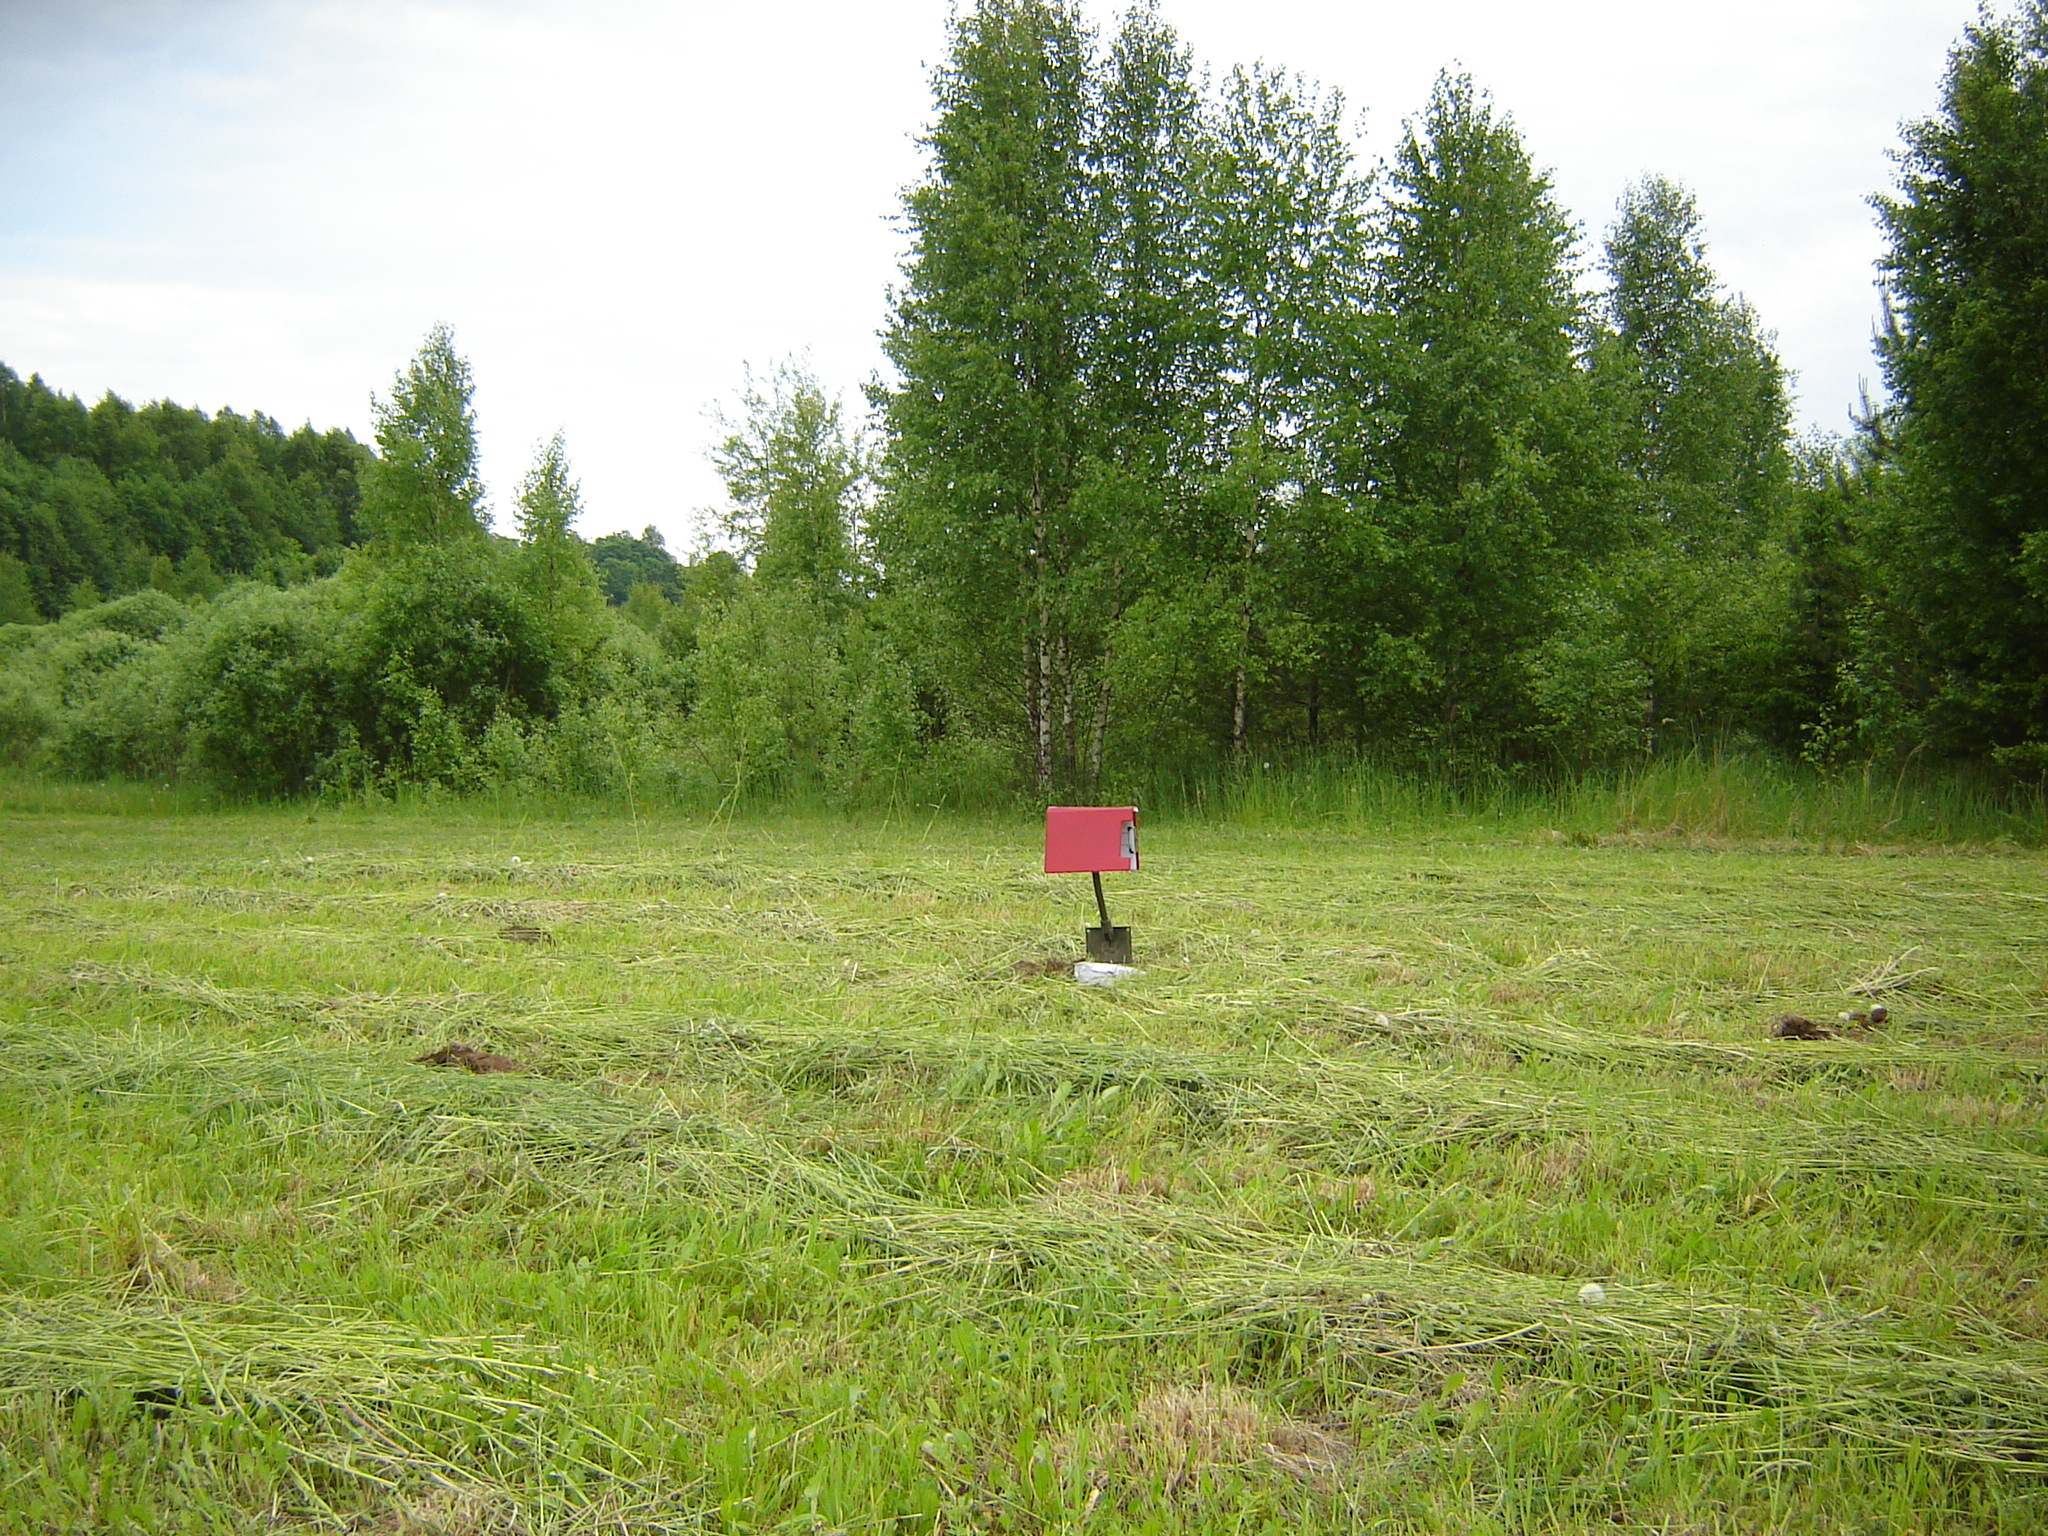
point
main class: Grassland
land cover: Grassland without tree/shrub cover
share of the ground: > 75 %
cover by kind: herbaceous plants 100 %
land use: Agriculture (excluding fallow land and kitchen gardens)
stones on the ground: < 10 %
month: June
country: LT
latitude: 55.7923
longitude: 25.6129
